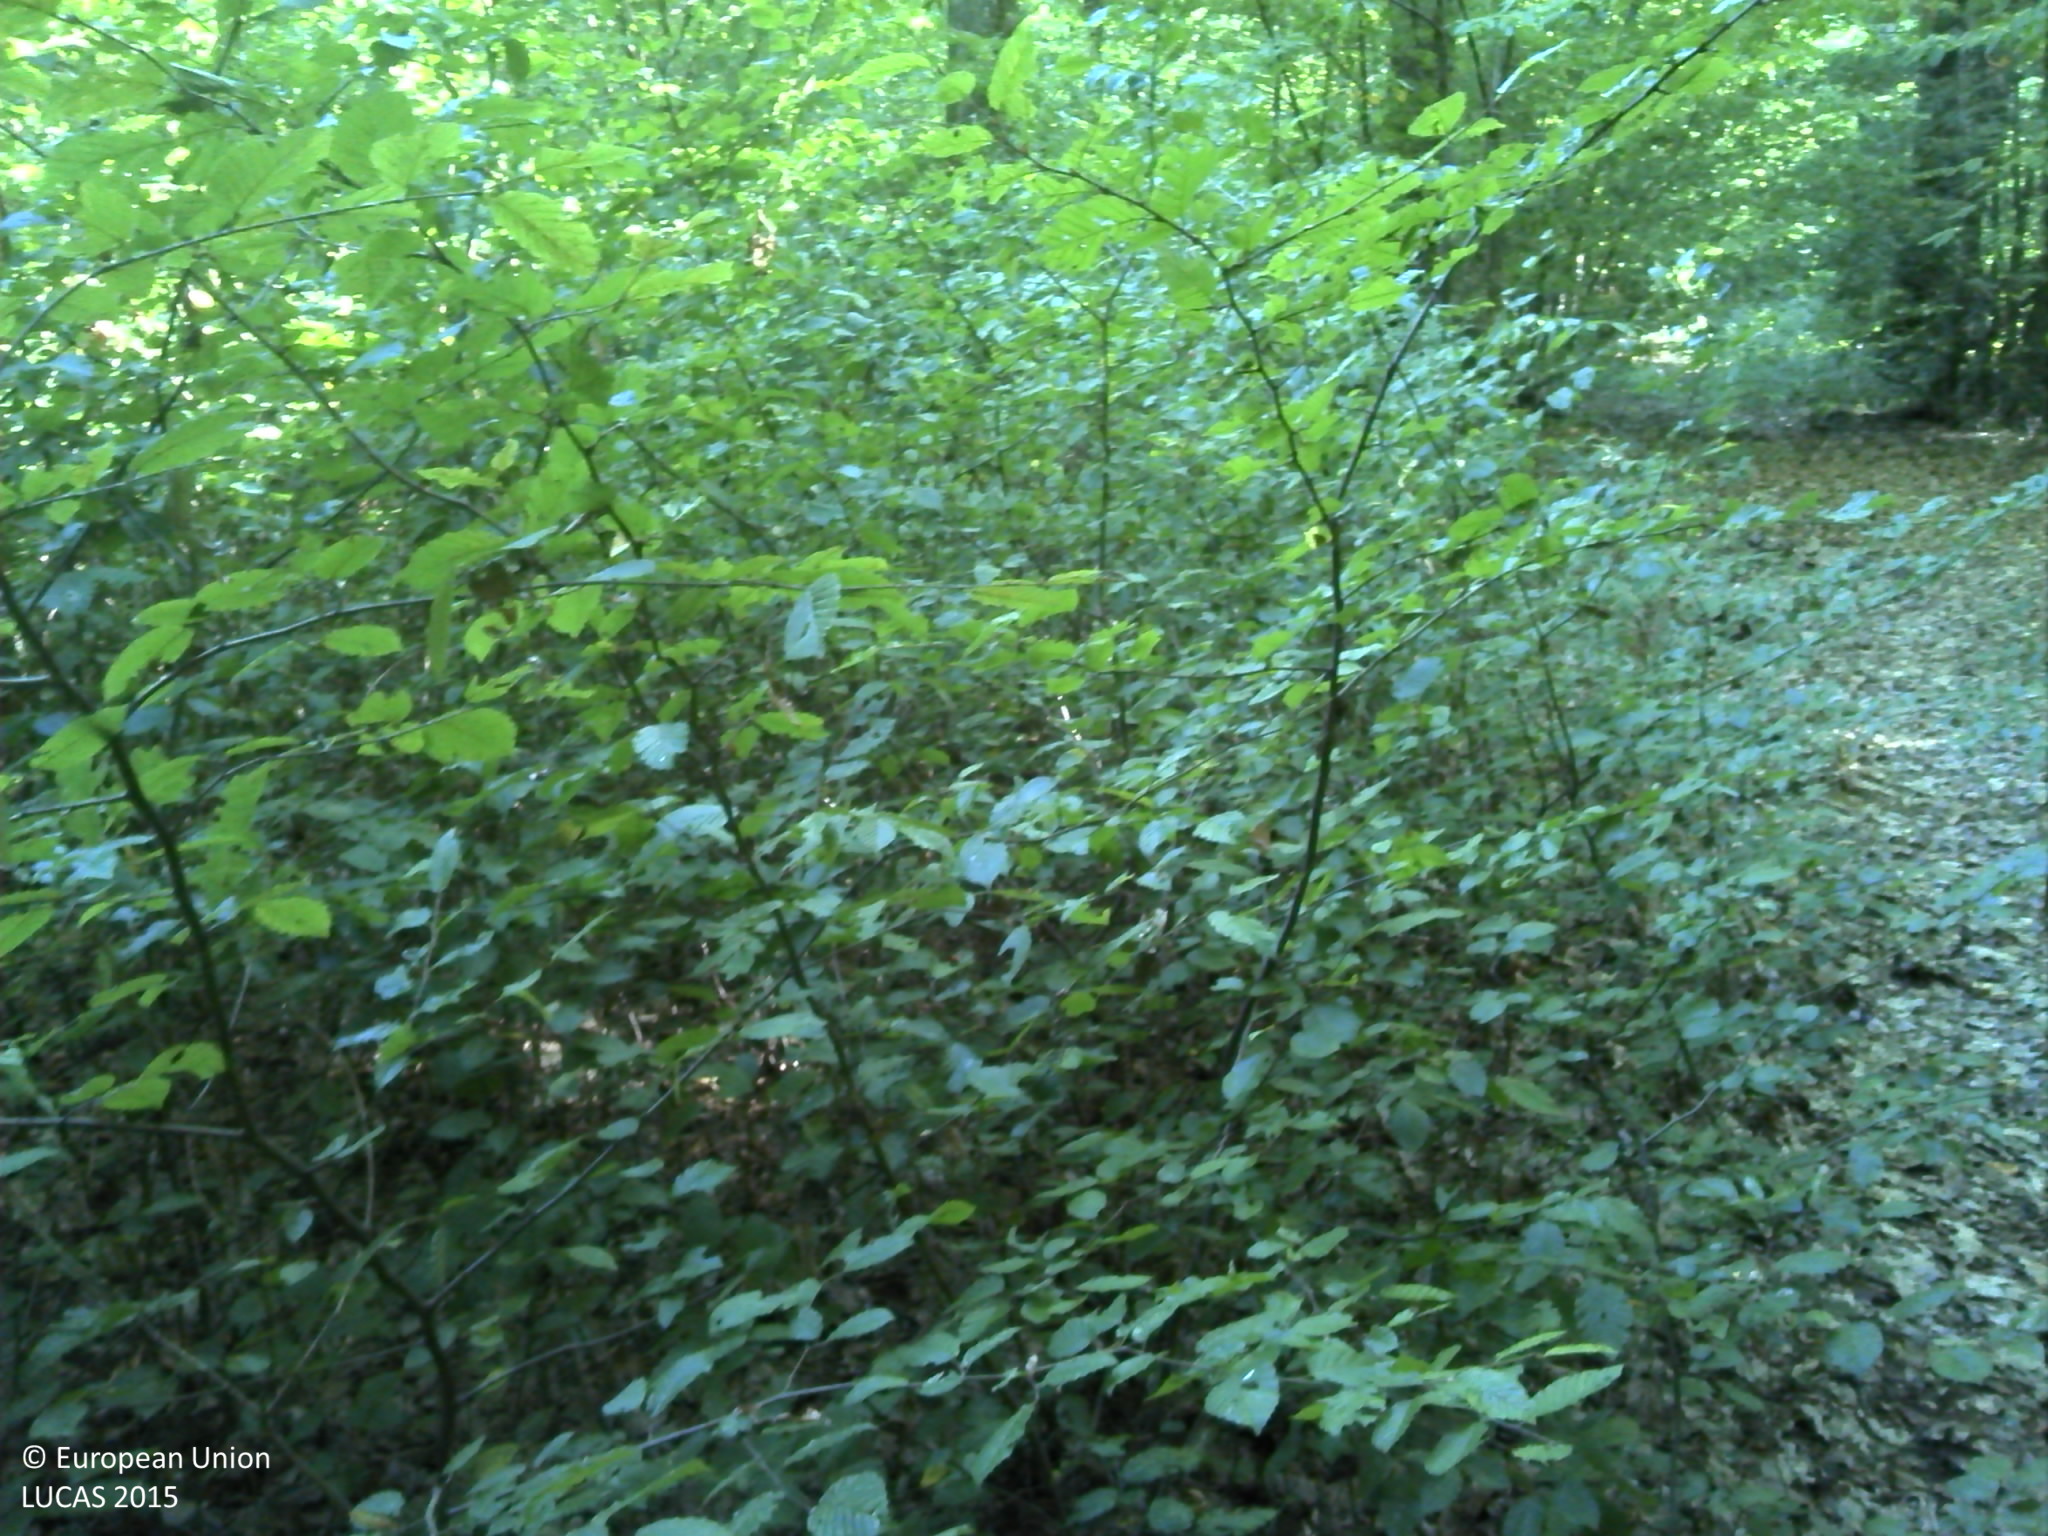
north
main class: Woodland
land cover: Broadleaved woodland
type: mesophytic deciduous forest
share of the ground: > 75 %
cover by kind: broadleaved forest trees 80 %, shrubs 15 %, herbaceous plants 5 %
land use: Forestry
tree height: > 5 m
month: August
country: FR
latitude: 48.7166
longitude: 1.8436
